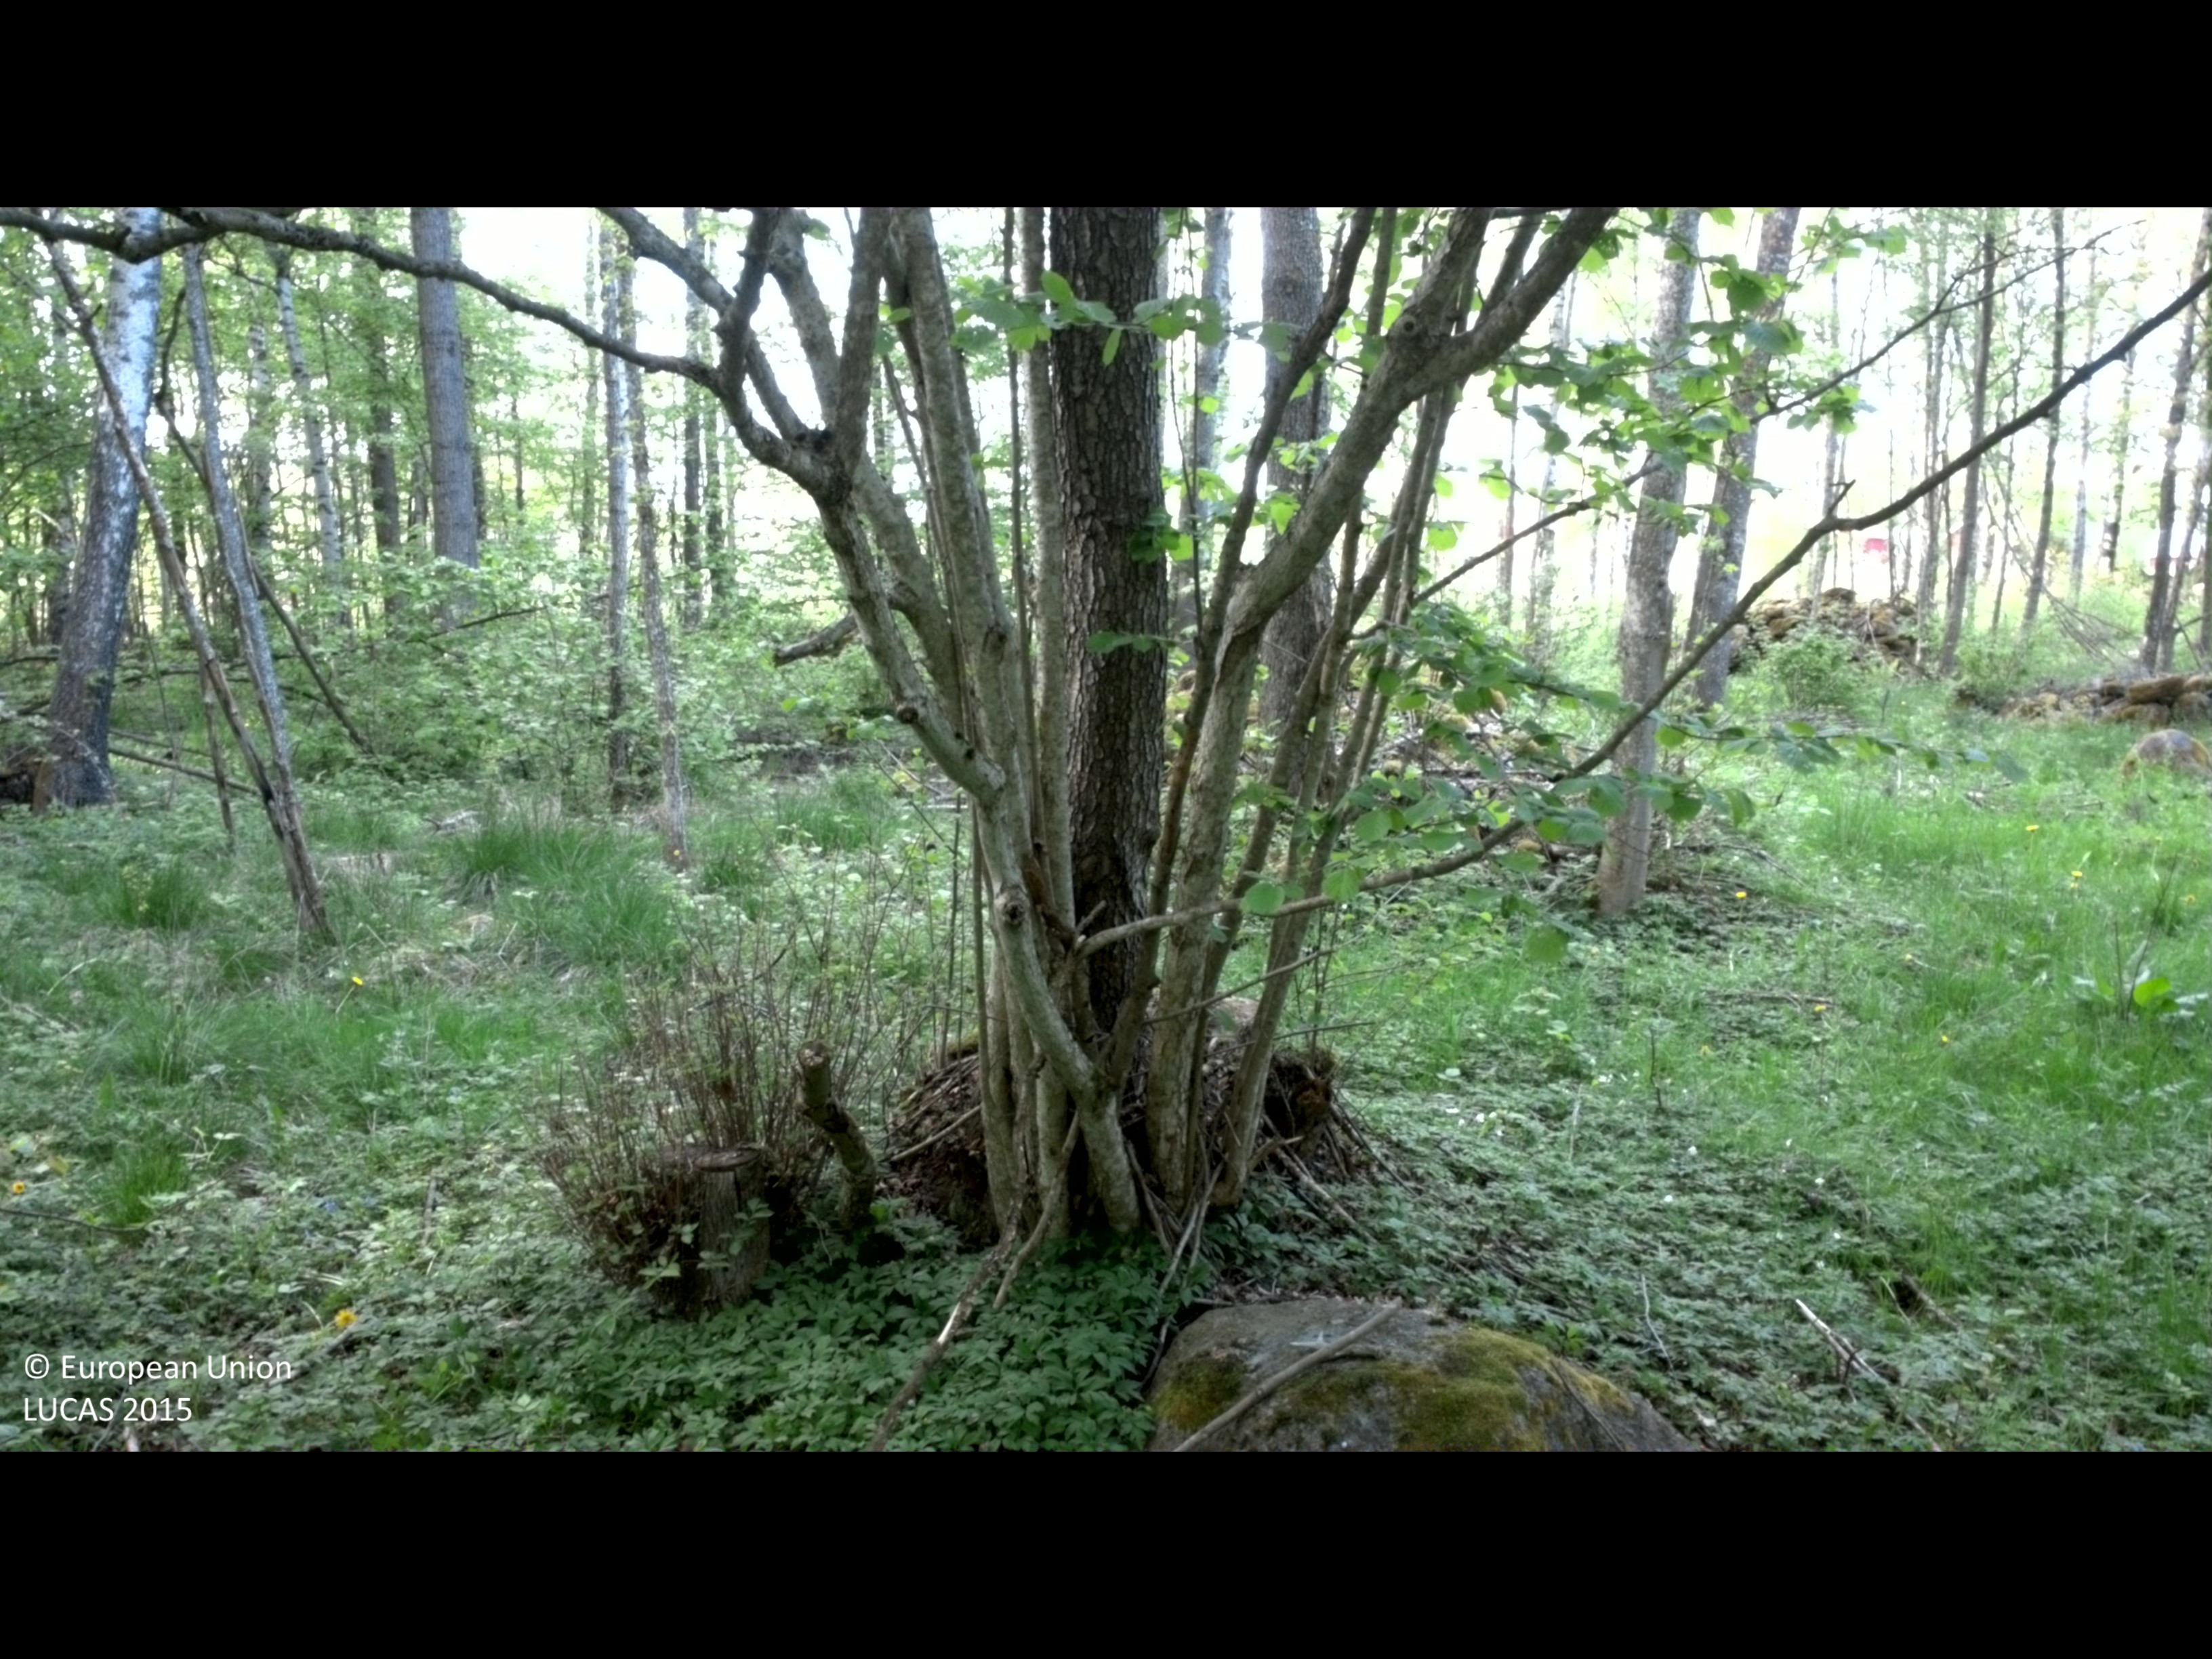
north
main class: Woodland
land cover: Broadleaved woodland
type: non-riverine alder, birch or aspen forest
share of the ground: 25 - 50 %
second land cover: Grassland without tree/shrub cover
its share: 50 - 75 %
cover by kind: herbaceous plants 50 %, broadleaved forest trees 45 %, shrubs 5 %
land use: Forestry
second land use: Agriculture (excluding fallow land and kitchen gardens)
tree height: > 5 m
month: May
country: SE
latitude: 57.3579
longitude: 16.1323
